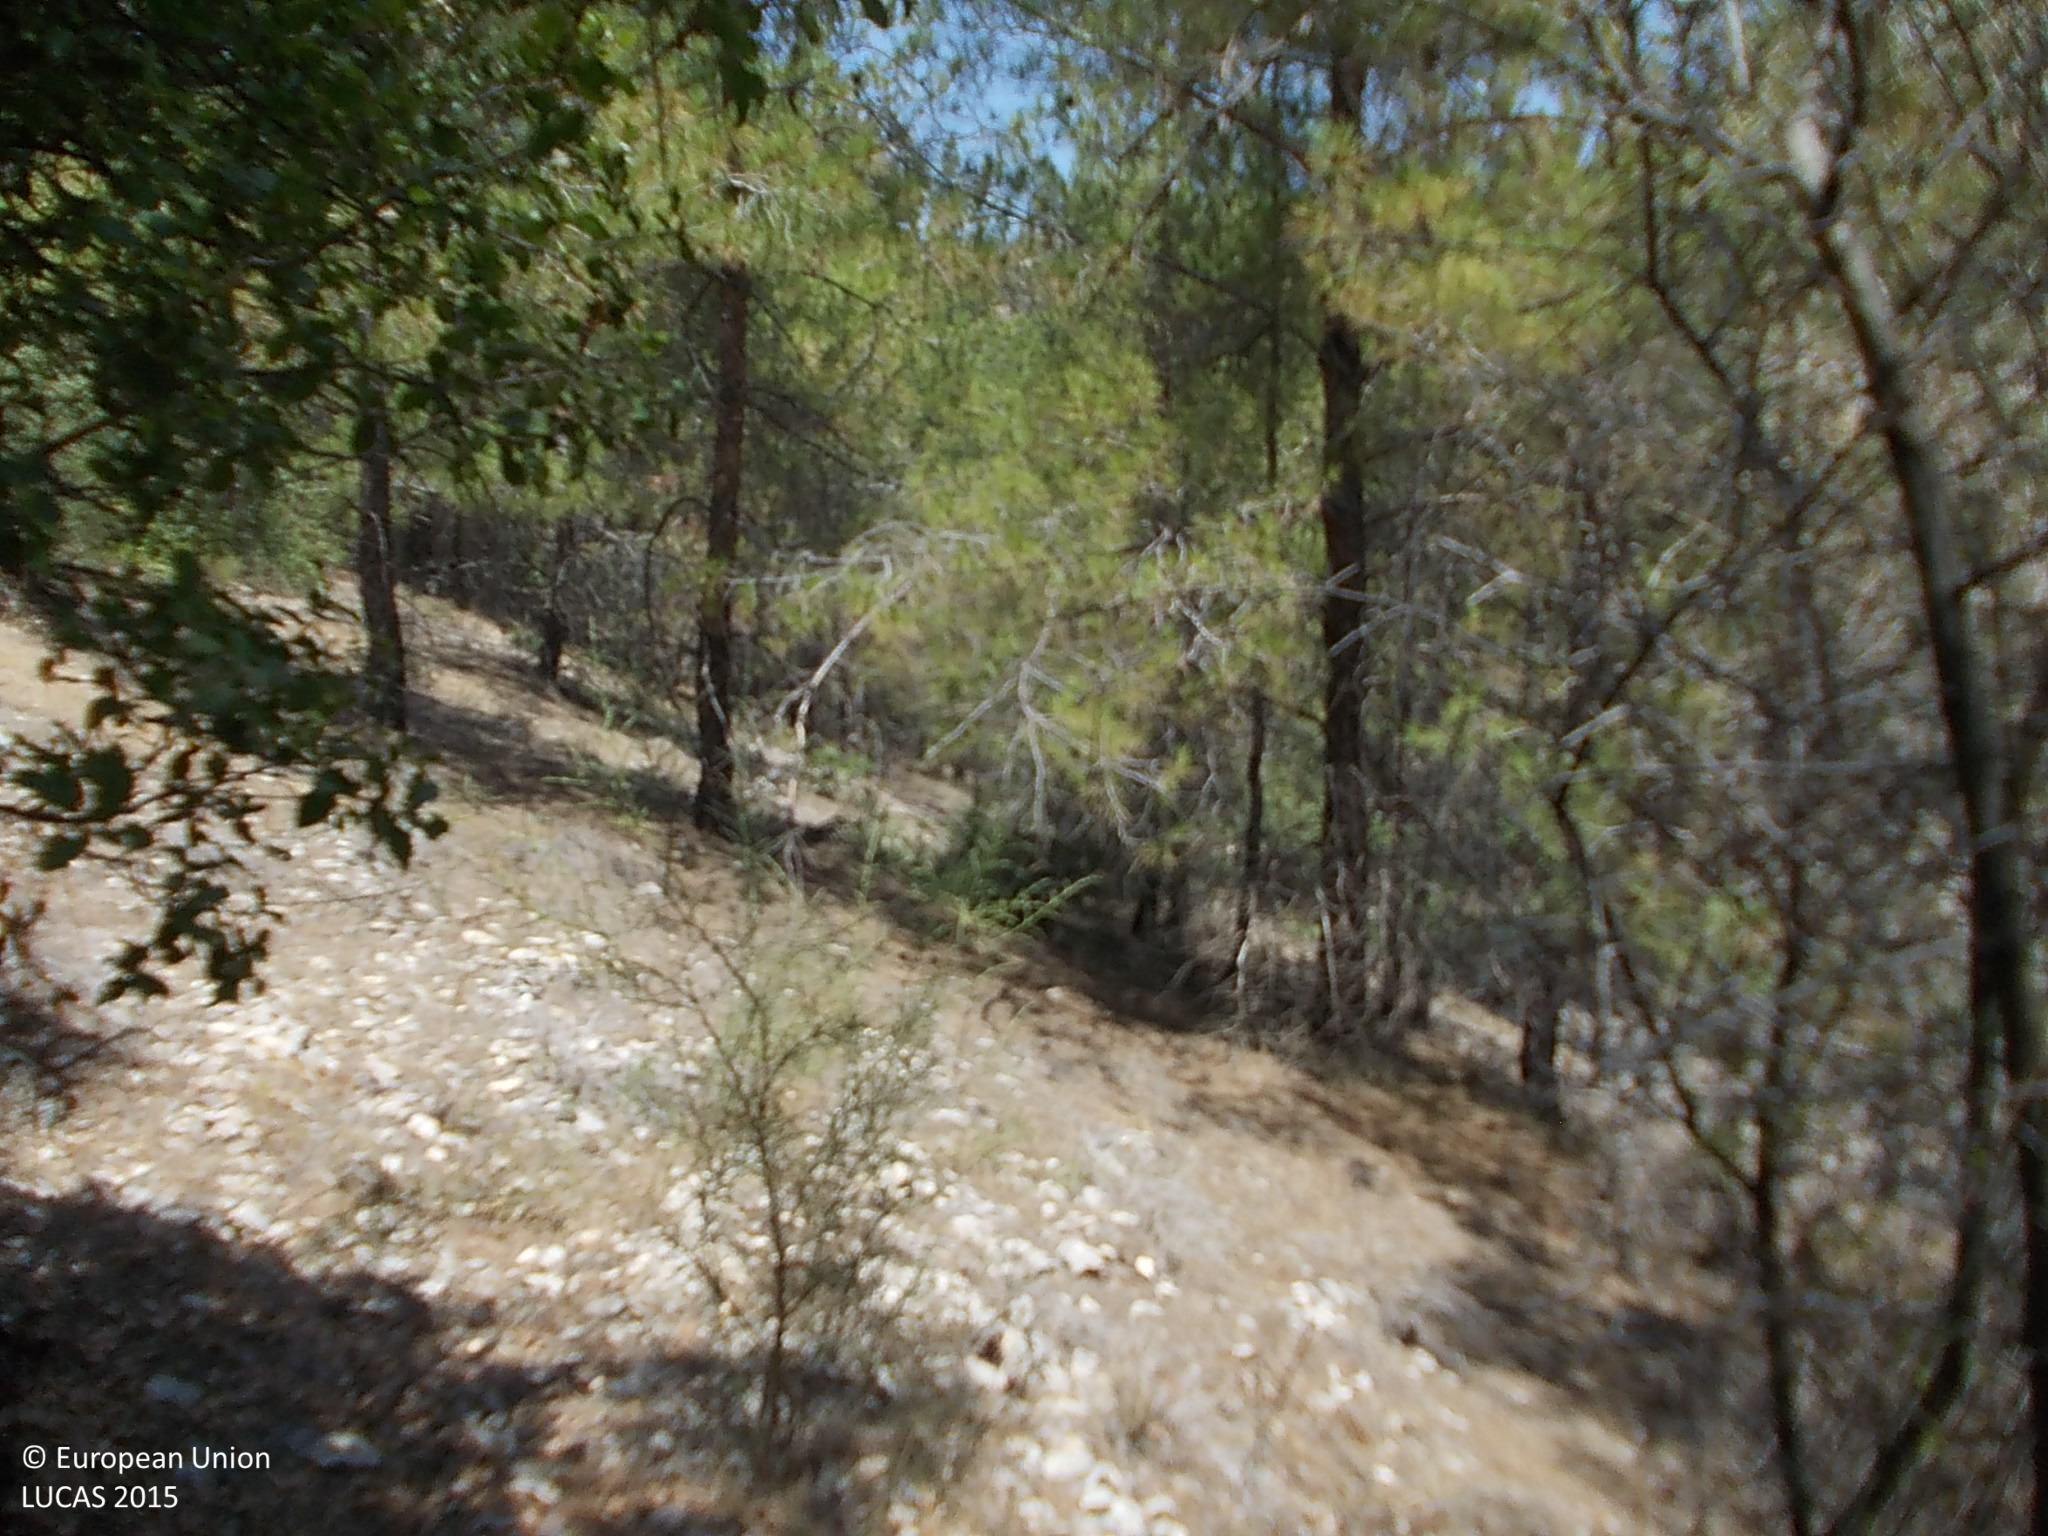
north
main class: Woodland
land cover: Pine dominated coniferous woodland
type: coniferous forest of the mediterranean region
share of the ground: > 75 %
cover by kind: coniferous forest trees 75 %, shrubs 10 %, unconsolidated bare surface 10 %, broadleaved forest trees 5 %
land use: Semi-natural and natural areas not in use
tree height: > 5 m
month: July
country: CY
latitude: 34.7544
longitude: 32.7132
